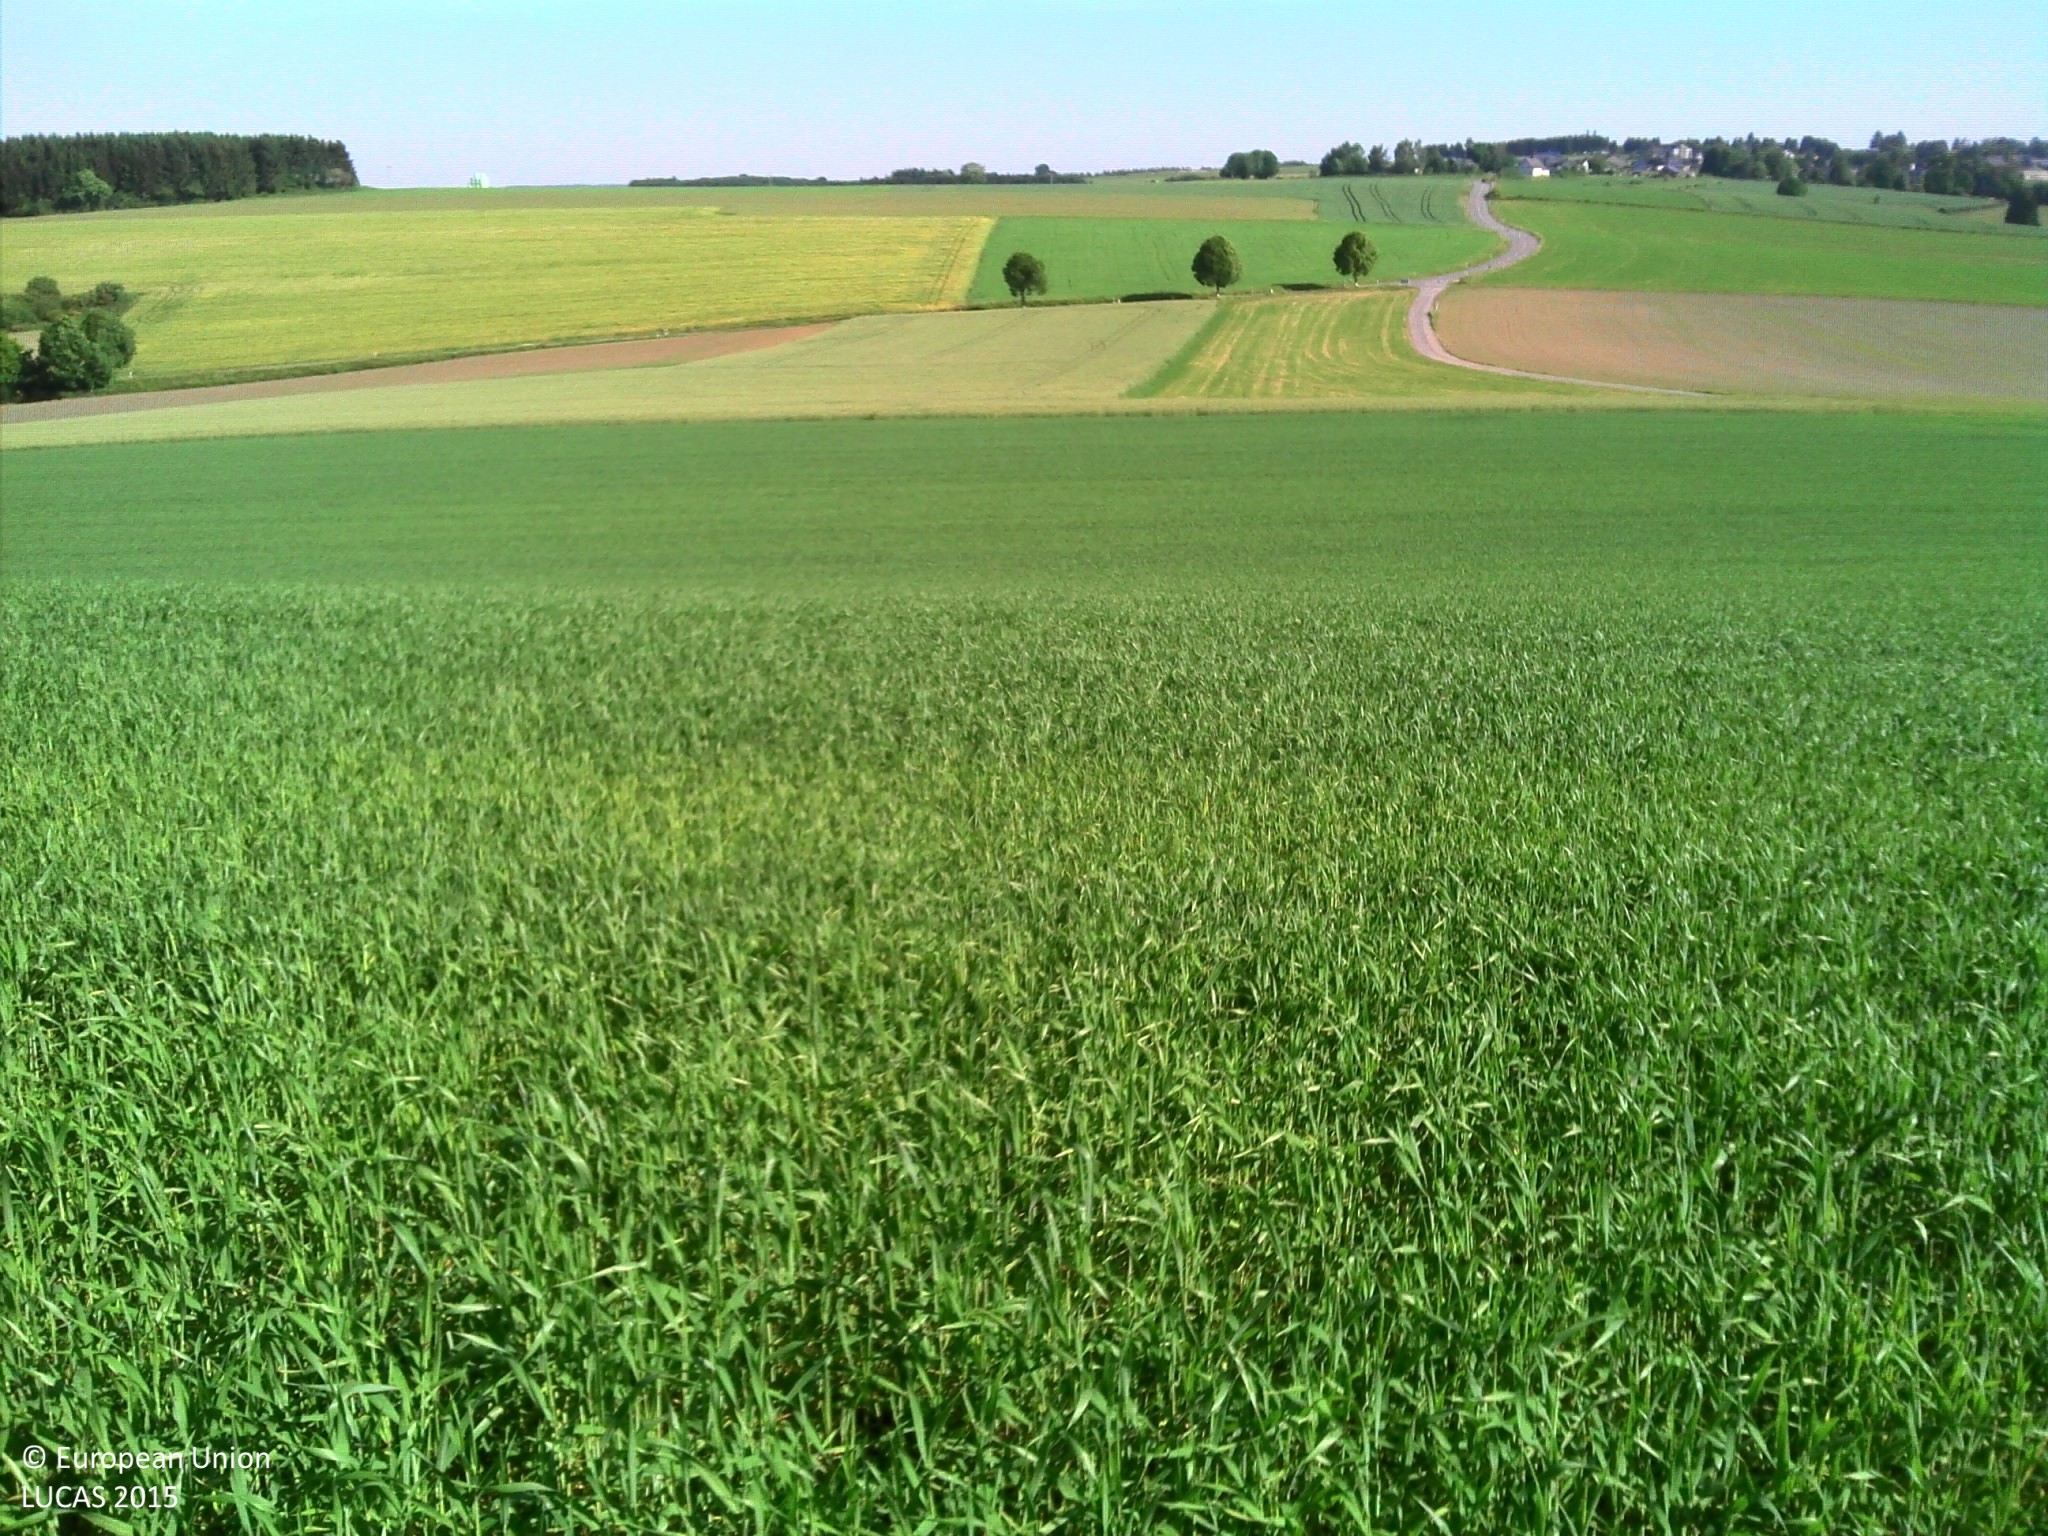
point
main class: Cropland
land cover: Triticale
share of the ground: > 75 %
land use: Agriculture (excluding fallow land and kitchen gardens)
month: June
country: LU
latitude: 49.8732
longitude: 5.8106
